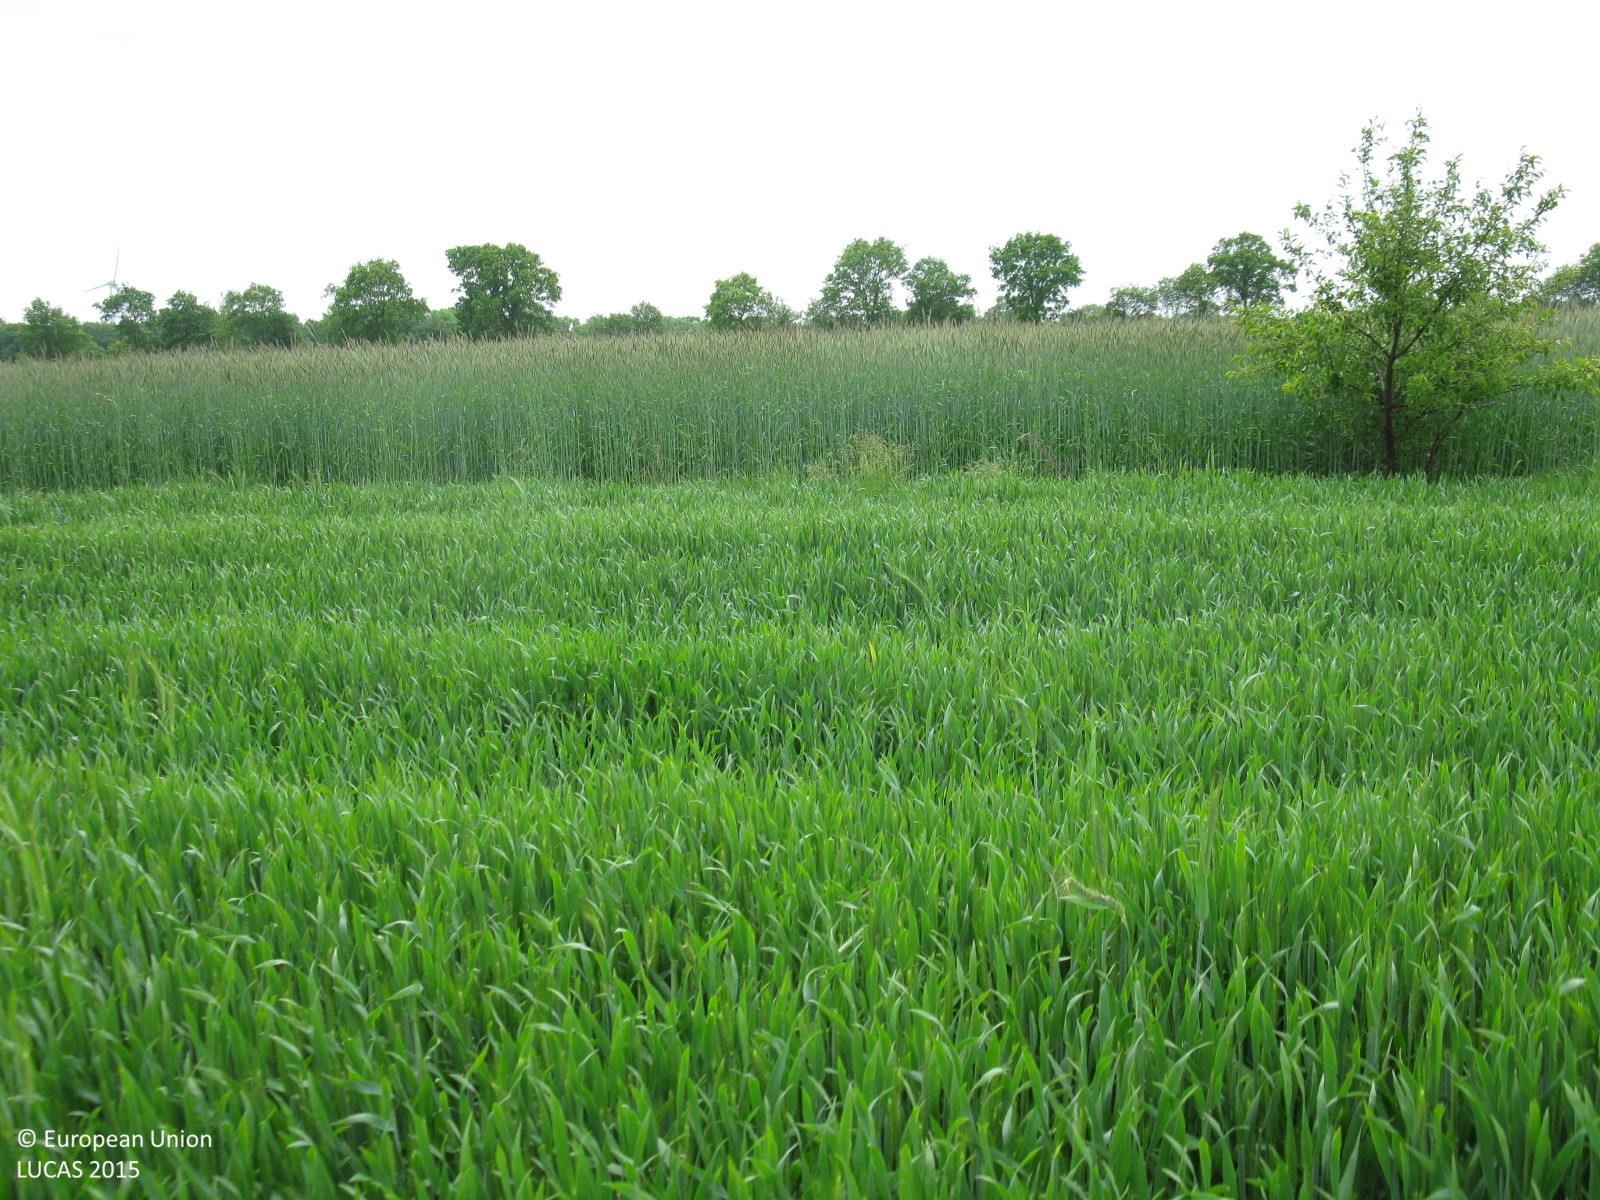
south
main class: Cropland
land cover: Triticale
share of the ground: > 75 %
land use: Agriculture (excluding fallow land and kitchen gardens)
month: May
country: DE
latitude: 52.9963
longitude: 7.3931
